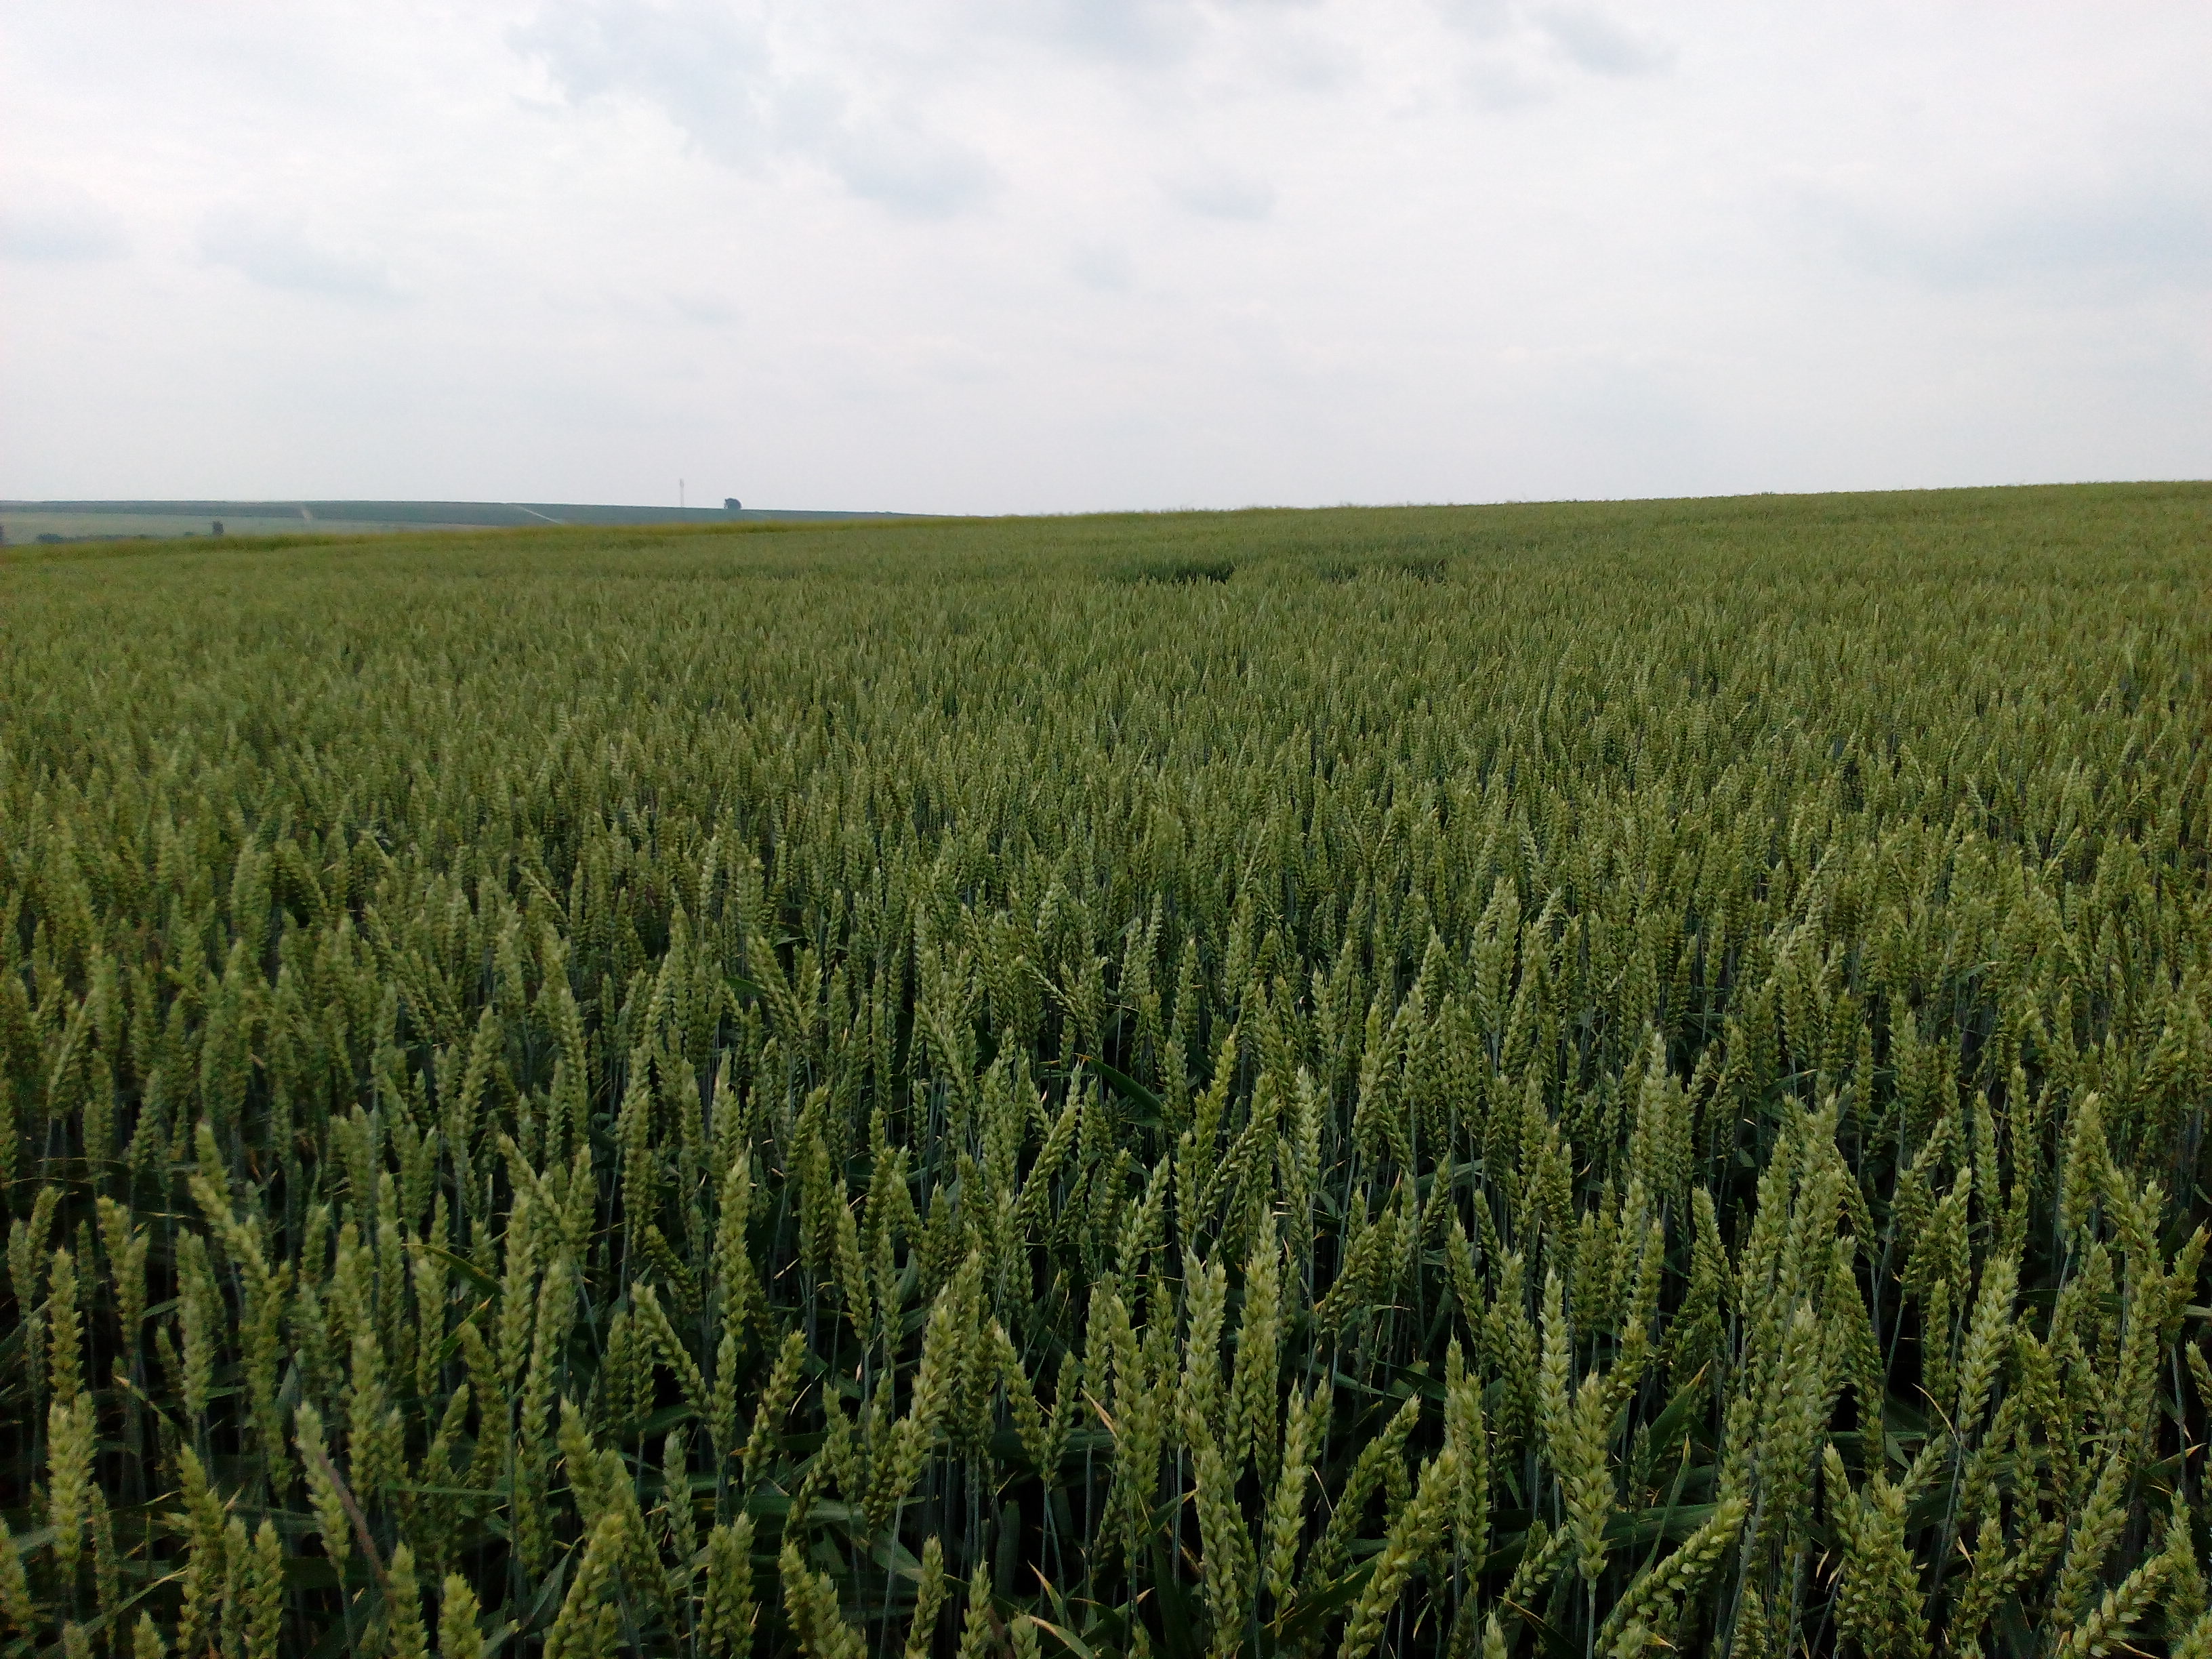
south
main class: Cropland
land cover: Common wheat
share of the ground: > 75 %
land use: Agriculture (excluding fallow land and kitchen gardens)
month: June
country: DE
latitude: 51.2757
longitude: 11.1035
